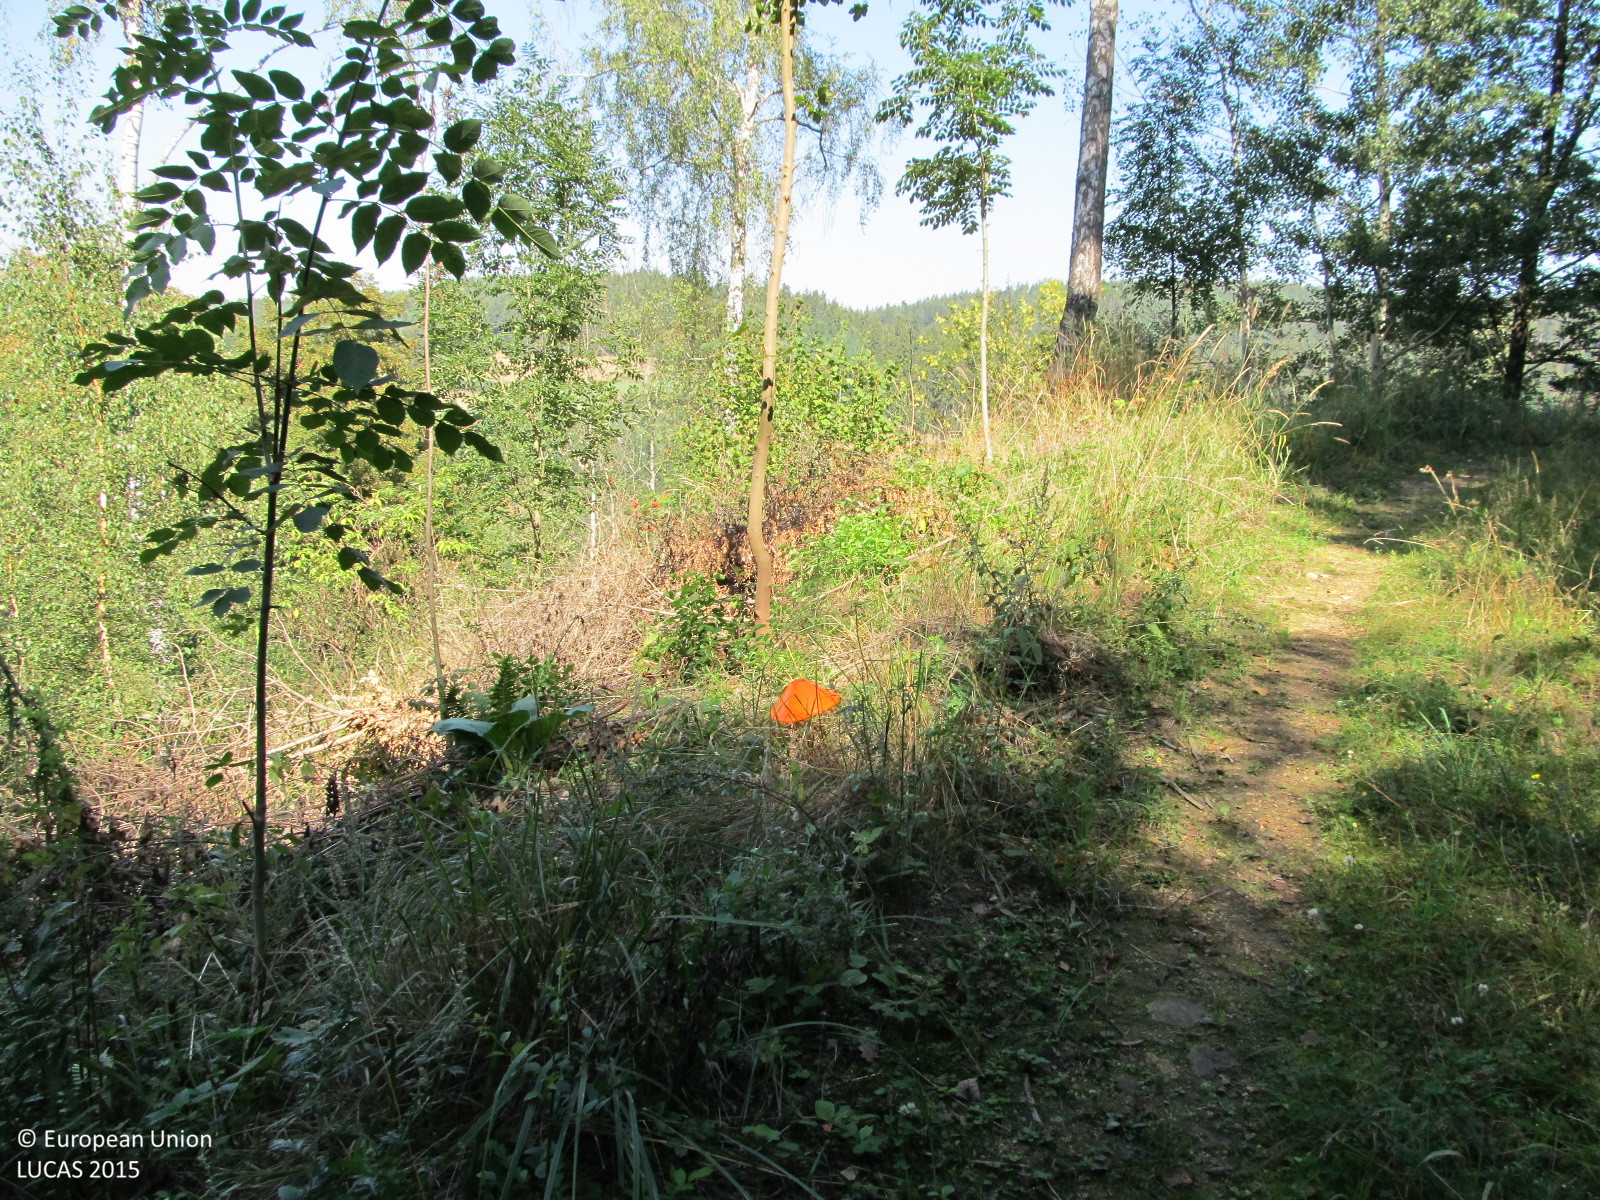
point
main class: Woodland
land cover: Broadleaved woodland
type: hemiboreal forest and nemoral coniferous forest and mixed broadleaved-coniferous forest
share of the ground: 25 - 50 %
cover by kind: herbaceous plants 55 %, broadleaved forest trees 25 %, shrubs 20 %
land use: Semi-natural and natural areas not in use
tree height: > 5 m
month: August
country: AT
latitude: 48.8247
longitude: 15.5197
